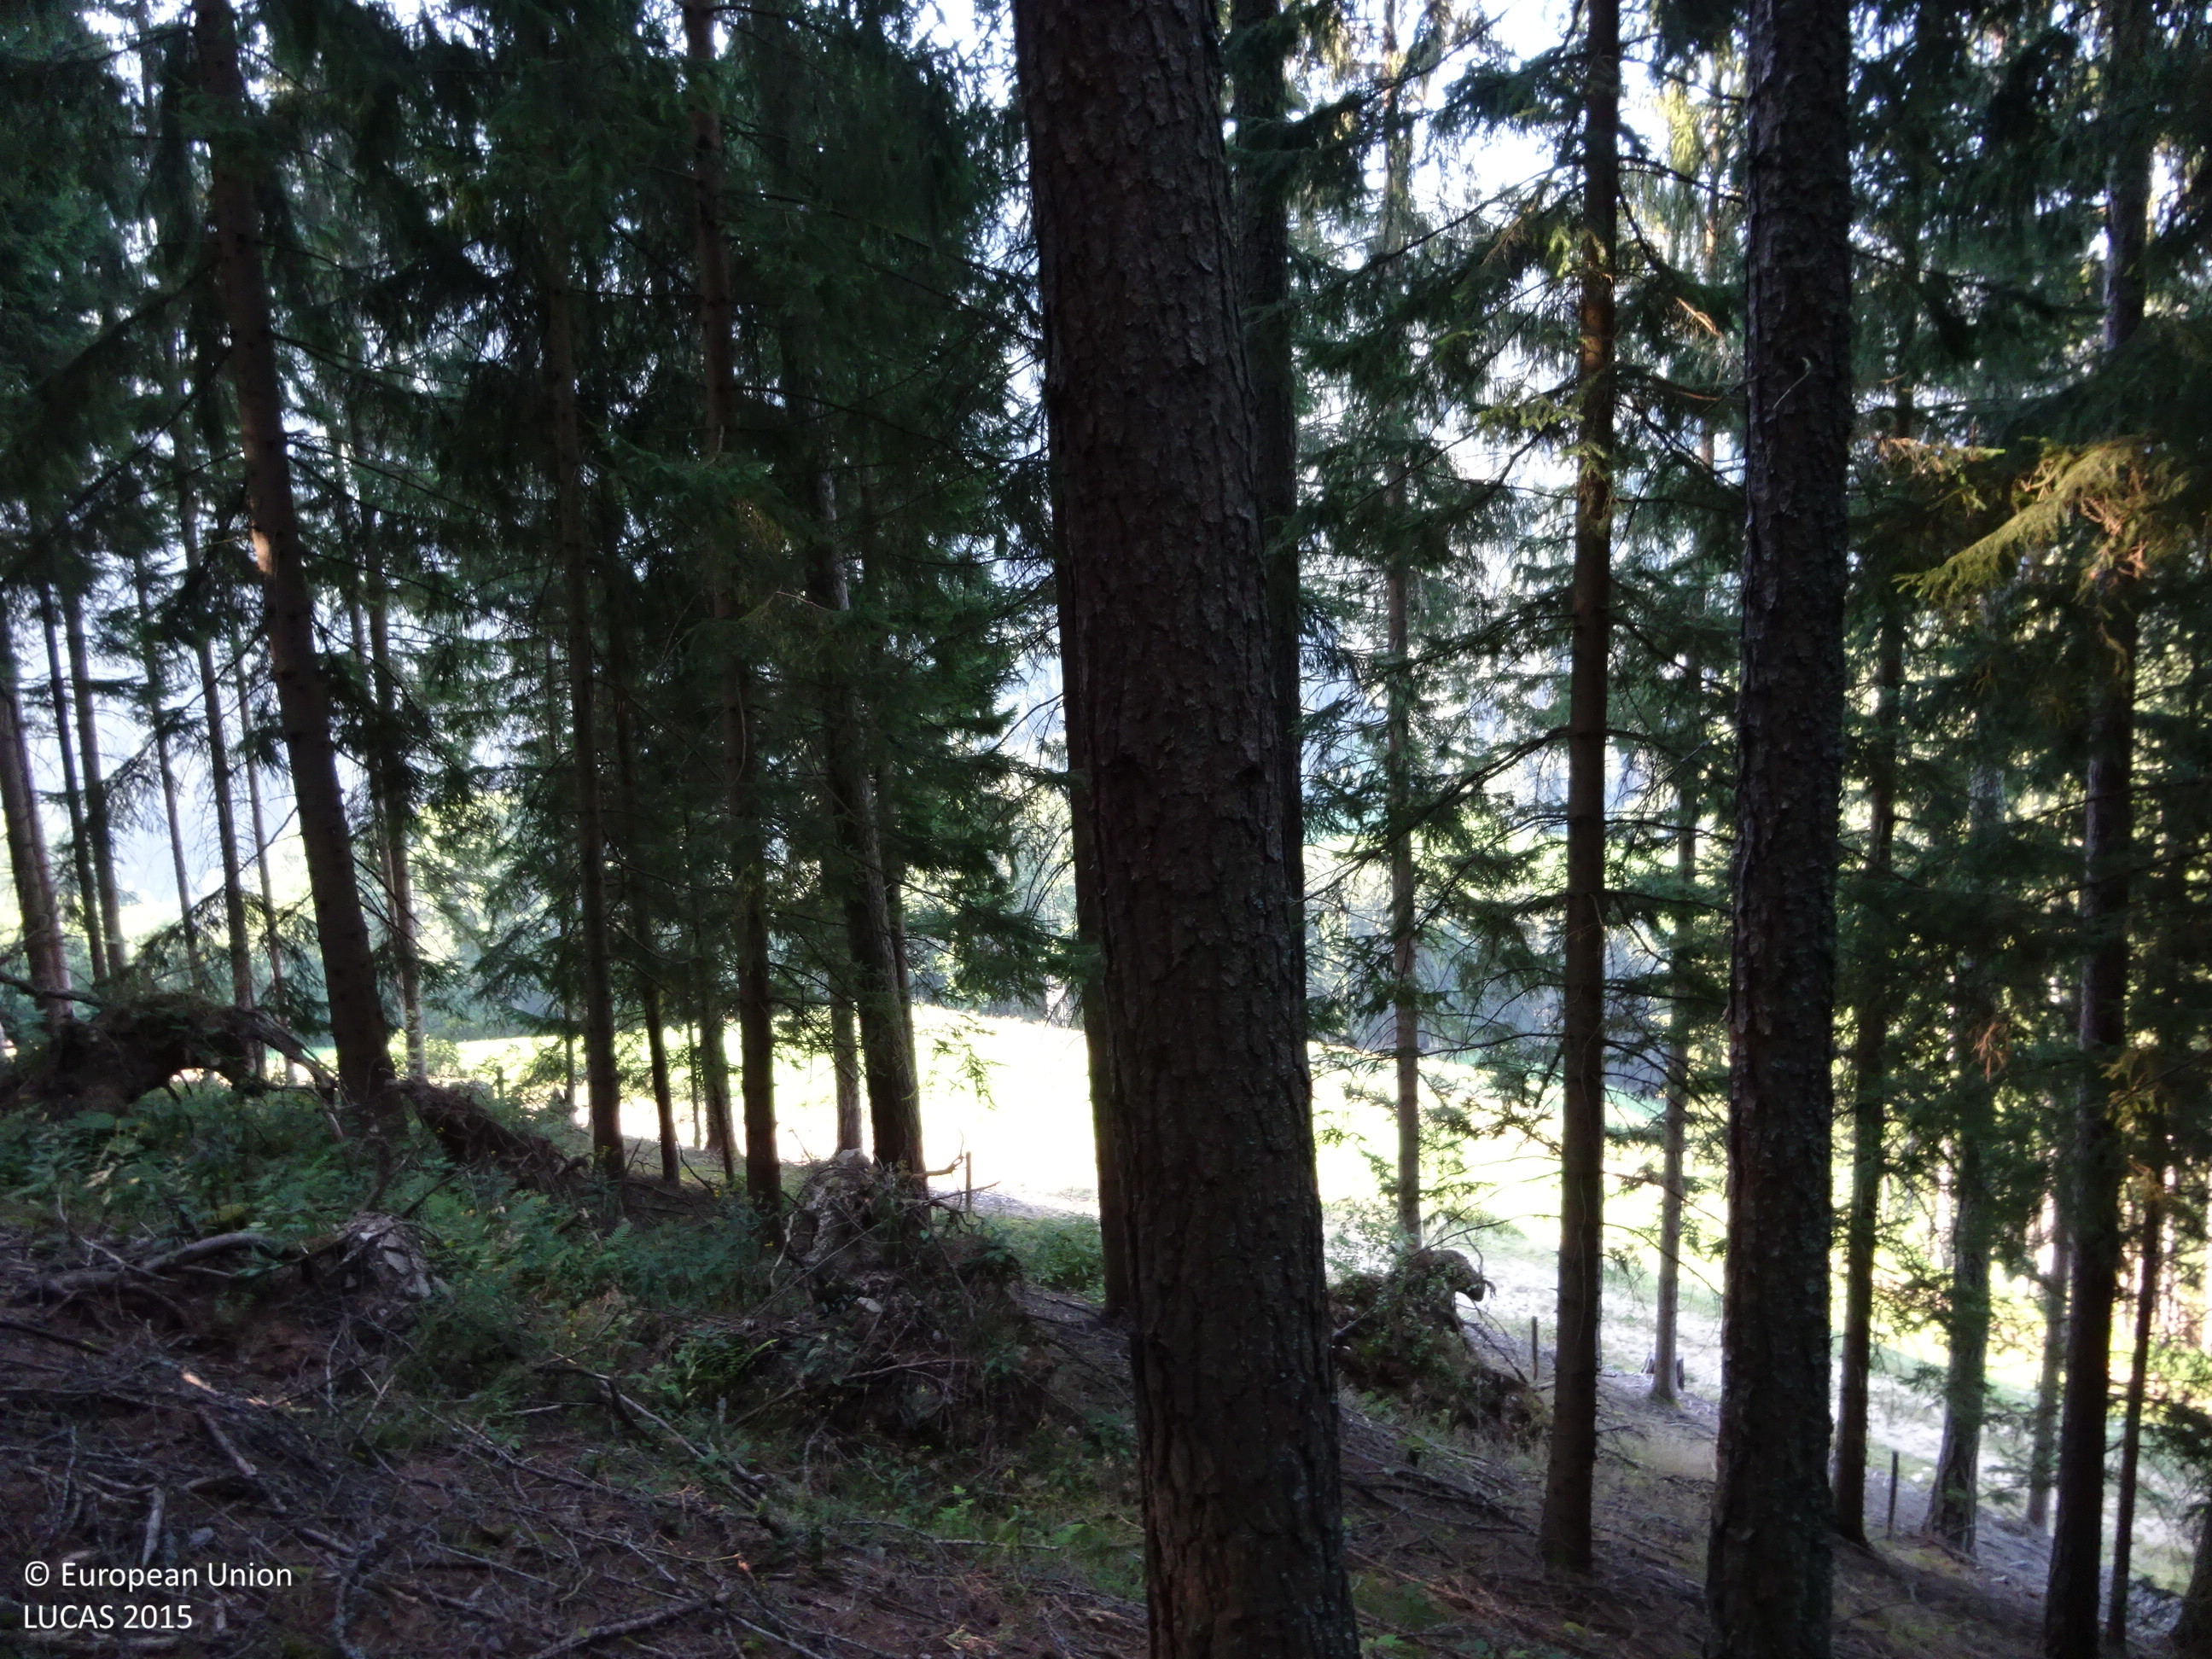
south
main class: Woodland
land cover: Other coniferous woodland
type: alpine coniferous forest
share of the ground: > 75 %
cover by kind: coniferous forest trees 100 %
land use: Forestry
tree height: > 5 m
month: August
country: AT
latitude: 47.4713
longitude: 15.5337
